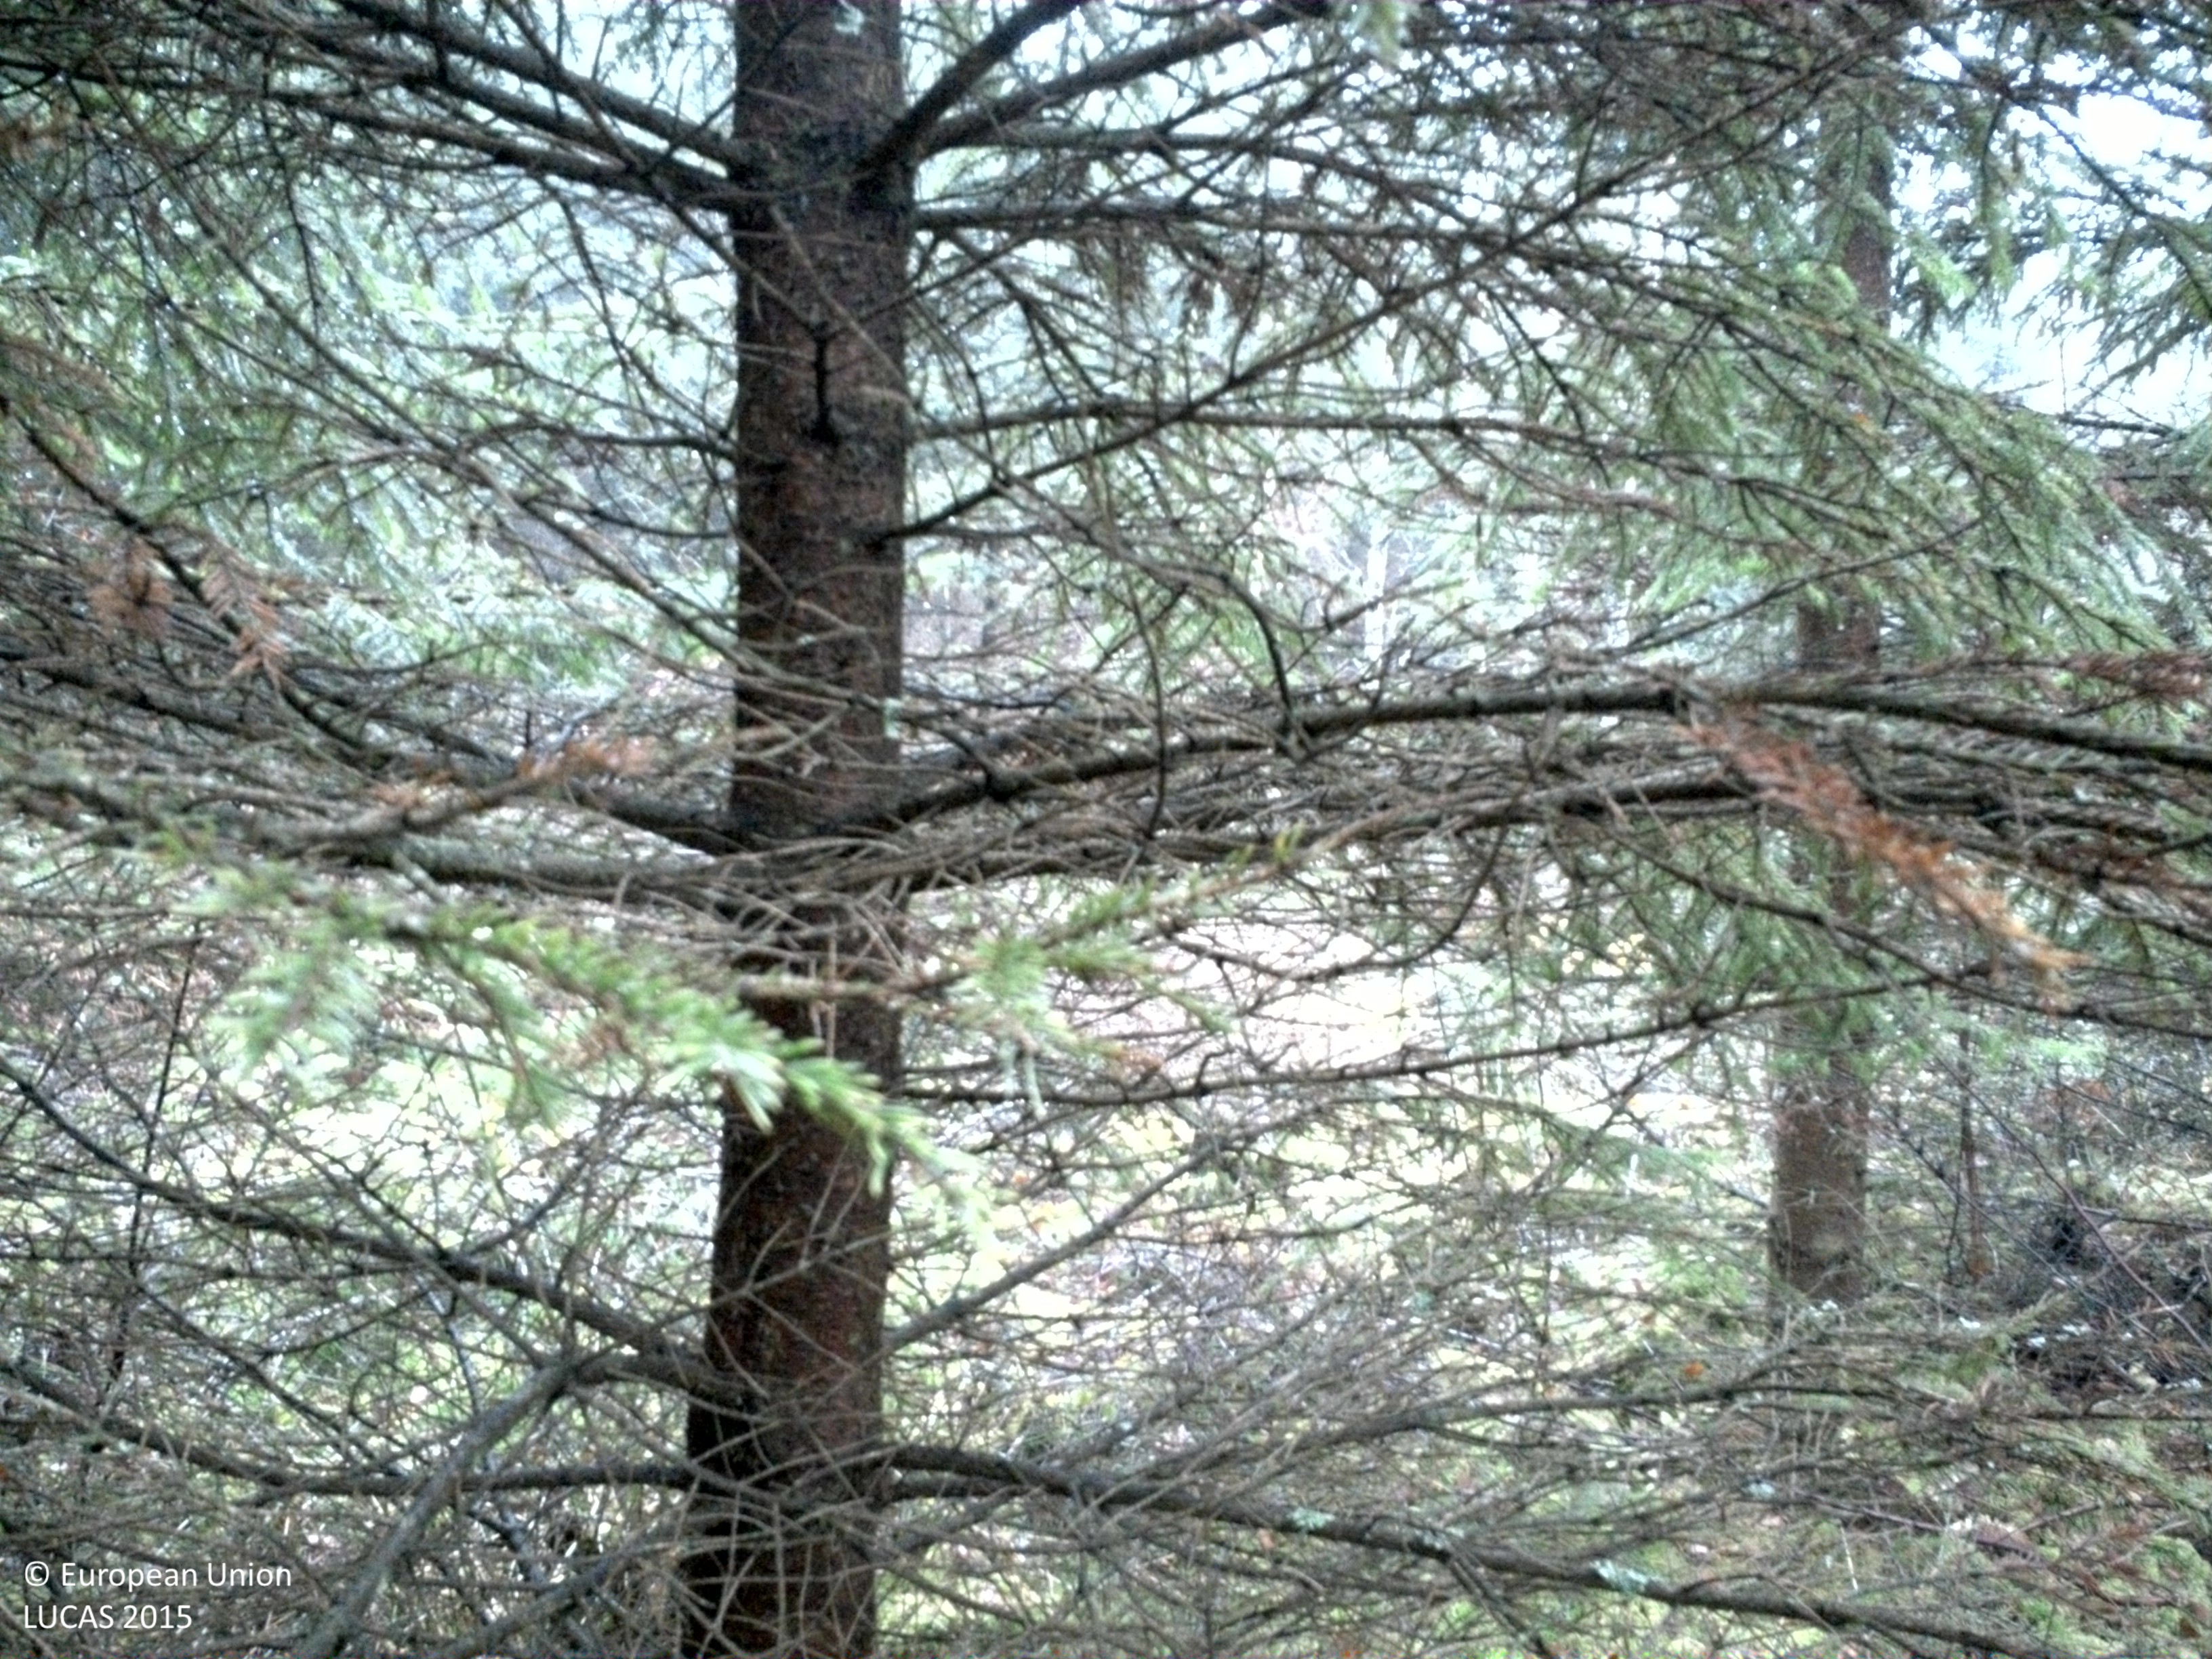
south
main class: Woodland
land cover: Spruce dominated coniferous woodland
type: hemiboreal forest and nemoral coniferous forest and mixed broadleaved-coniferous forest
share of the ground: > 75 %
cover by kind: coniferous forest trees 85 %, lichens and mosses 10 %, unconsolidated bare surface 5 %
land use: Forestry
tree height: > 5 m
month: November
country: SE
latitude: 56.2026
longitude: 13.1729
